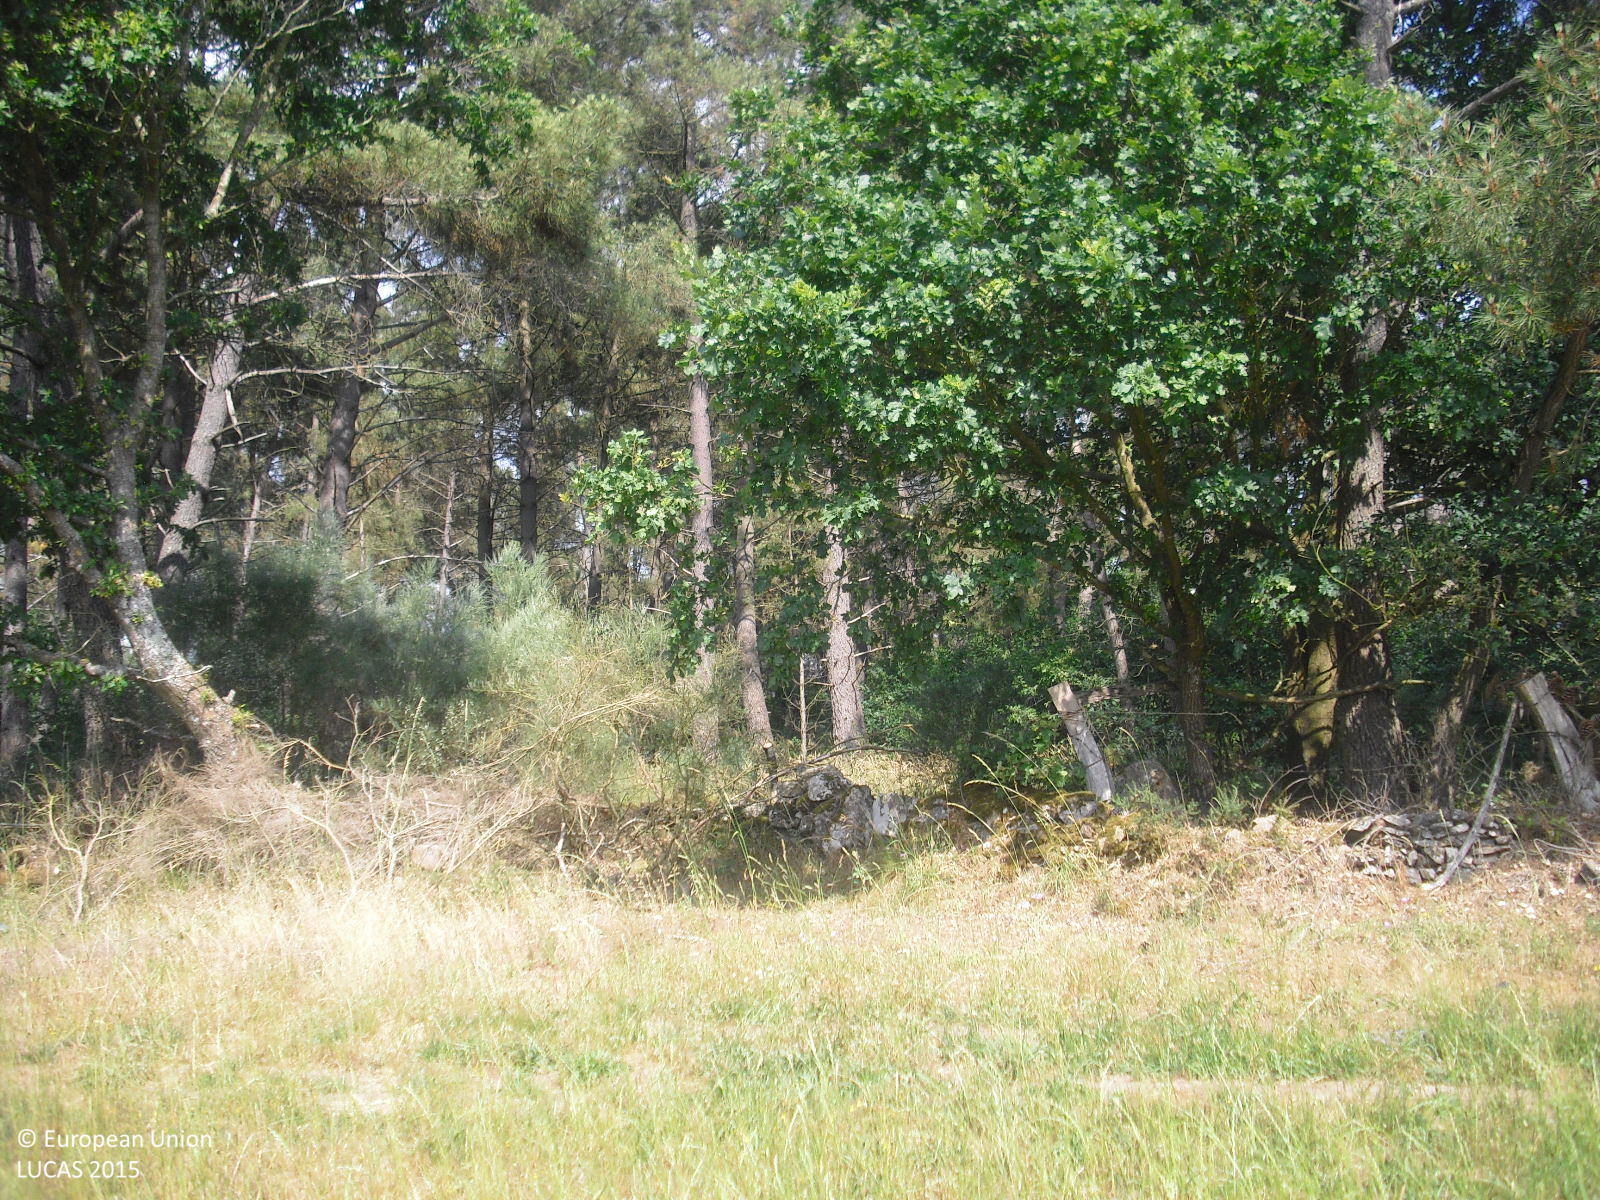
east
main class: Cropland
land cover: Temporary grasslands
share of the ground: > 75 %
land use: Agriculture (excluding fallow land and kitchen gardens)
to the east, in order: Temporary grasslands; Tracks; Shruby margins; Dry stone walls; Shruby margins; Tracks; Grassland with sparse tree/shrub cover; Pine dominated mixed woodland; Shruby margins; Temporary grasslands; Shrubland with sparse tree cover
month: June
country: ES
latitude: 42.6091
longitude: -7.8154
